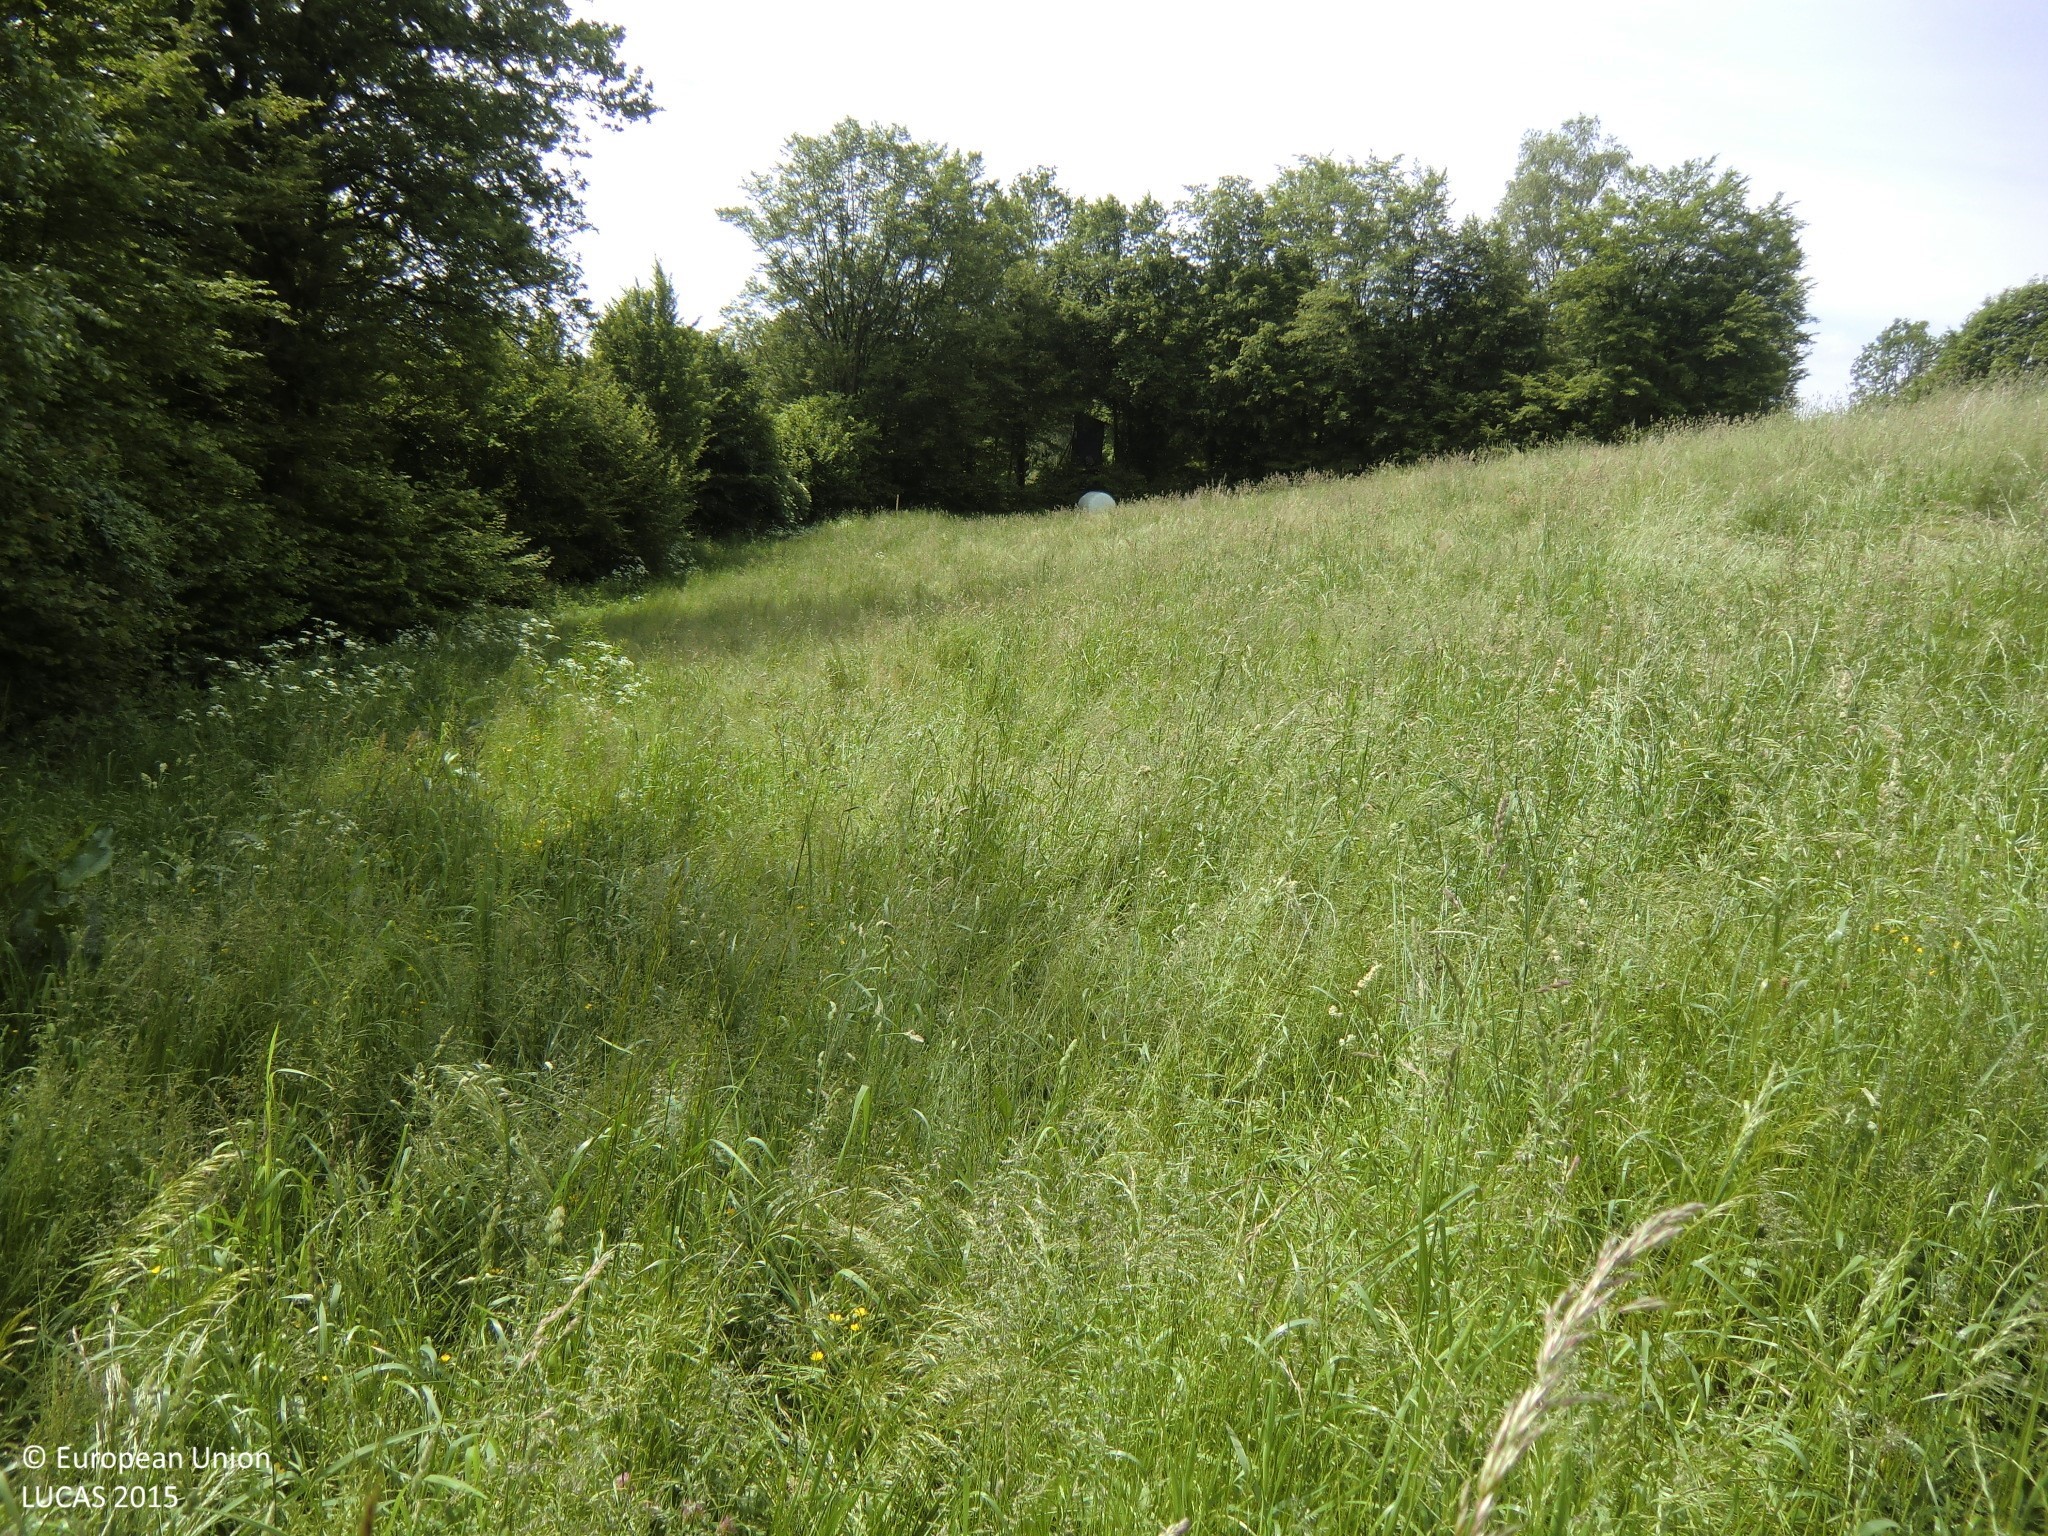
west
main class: Grassland
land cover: Grassland without tree/shrub cover
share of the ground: > 75 %
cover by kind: herbaceous plants 100 %
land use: Agriculture (excluding fallow land and kitchen gardens)
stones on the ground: < 10 %
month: May
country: AT
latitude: 48.2006
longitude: 14.9929
